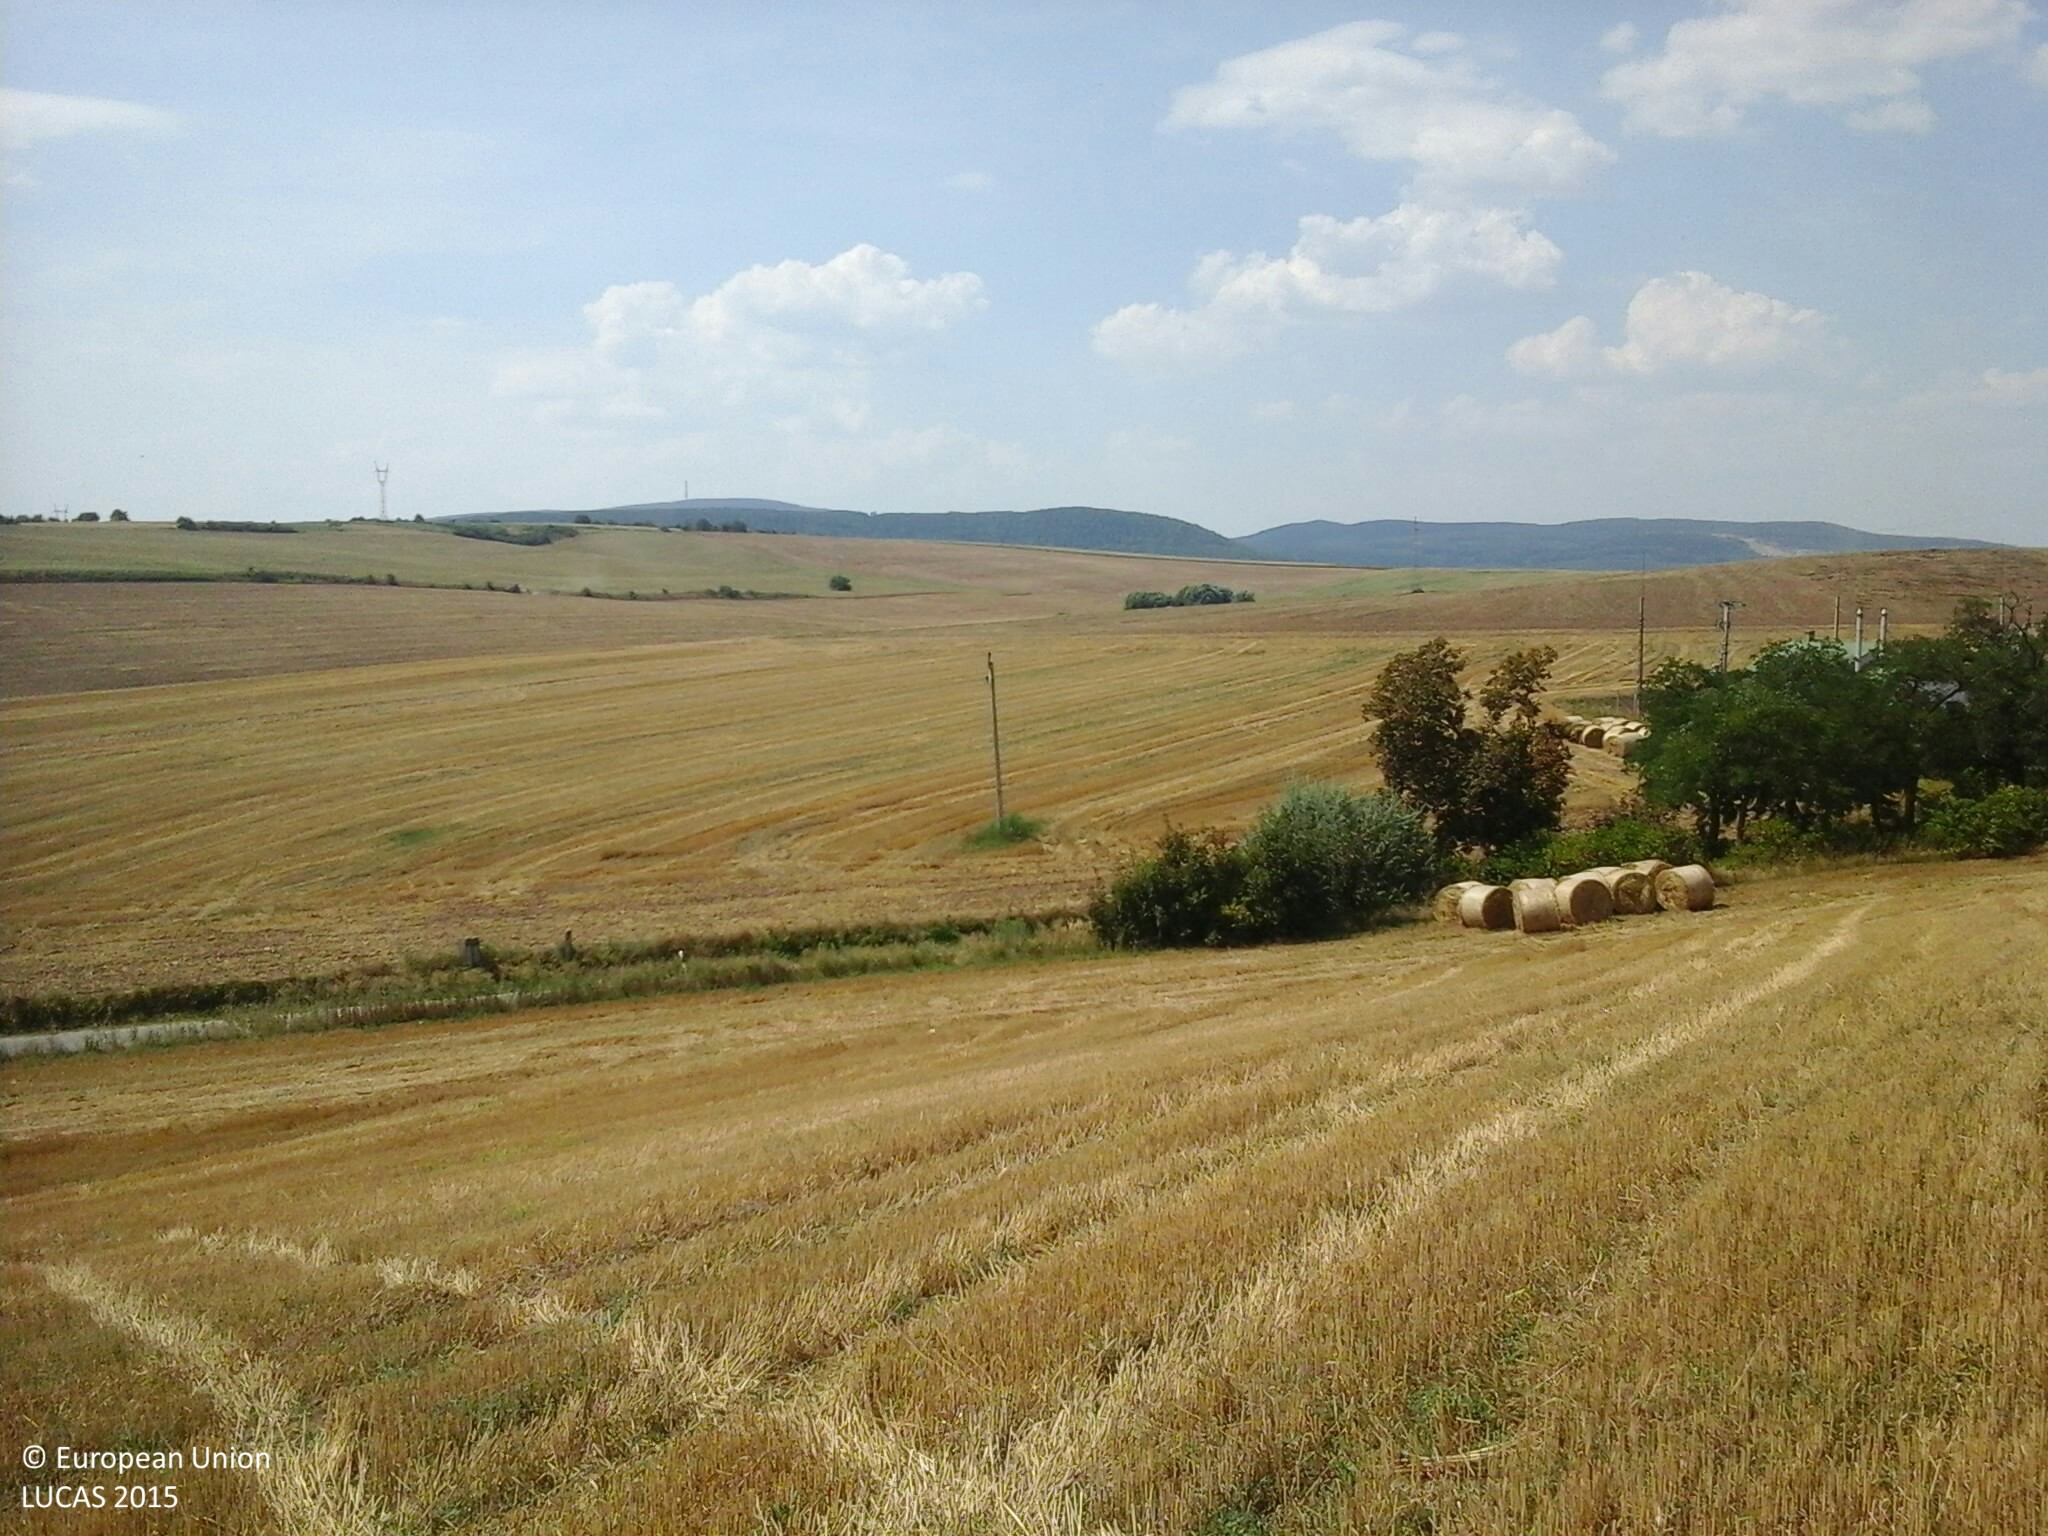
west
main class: Cropland
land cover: Common wheat
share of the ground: > 75 %
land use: Agriculture (excluding fallow land and kitchen gardens)
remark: Harvested field
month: August
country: HU
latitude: 47.6694
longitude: 18.6053
